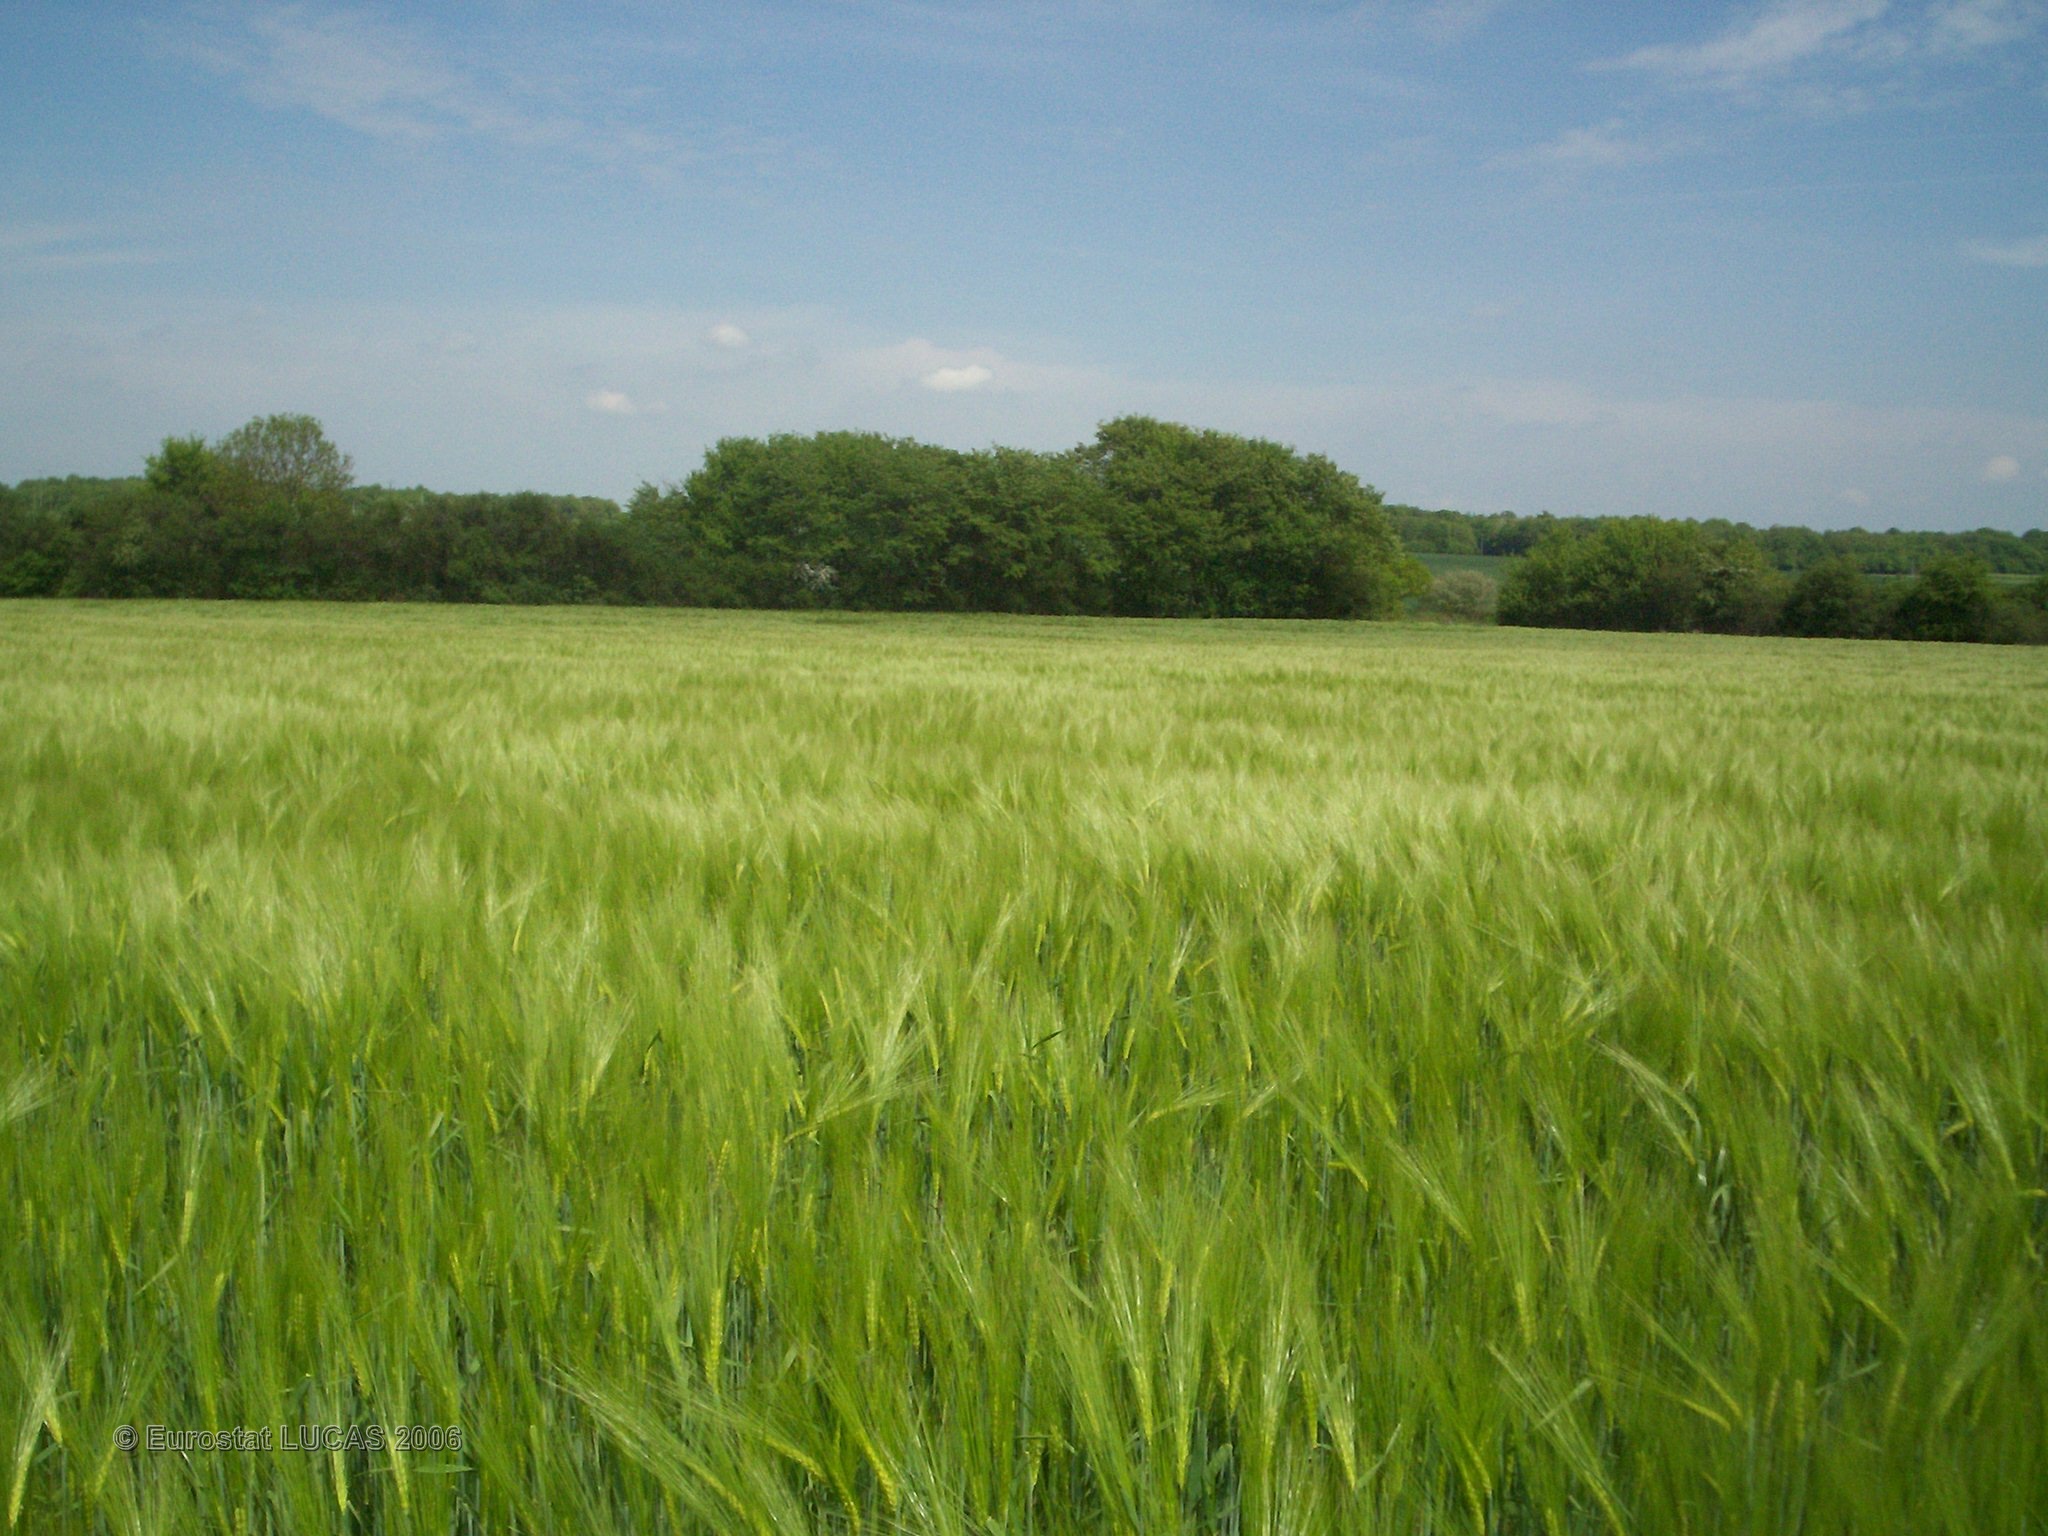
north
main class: Cropland
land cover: Barley
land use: Agriculture (excluding fallow land and kitchen gardens)
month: May
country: FR
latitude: 47.6563
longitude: 2.9769
